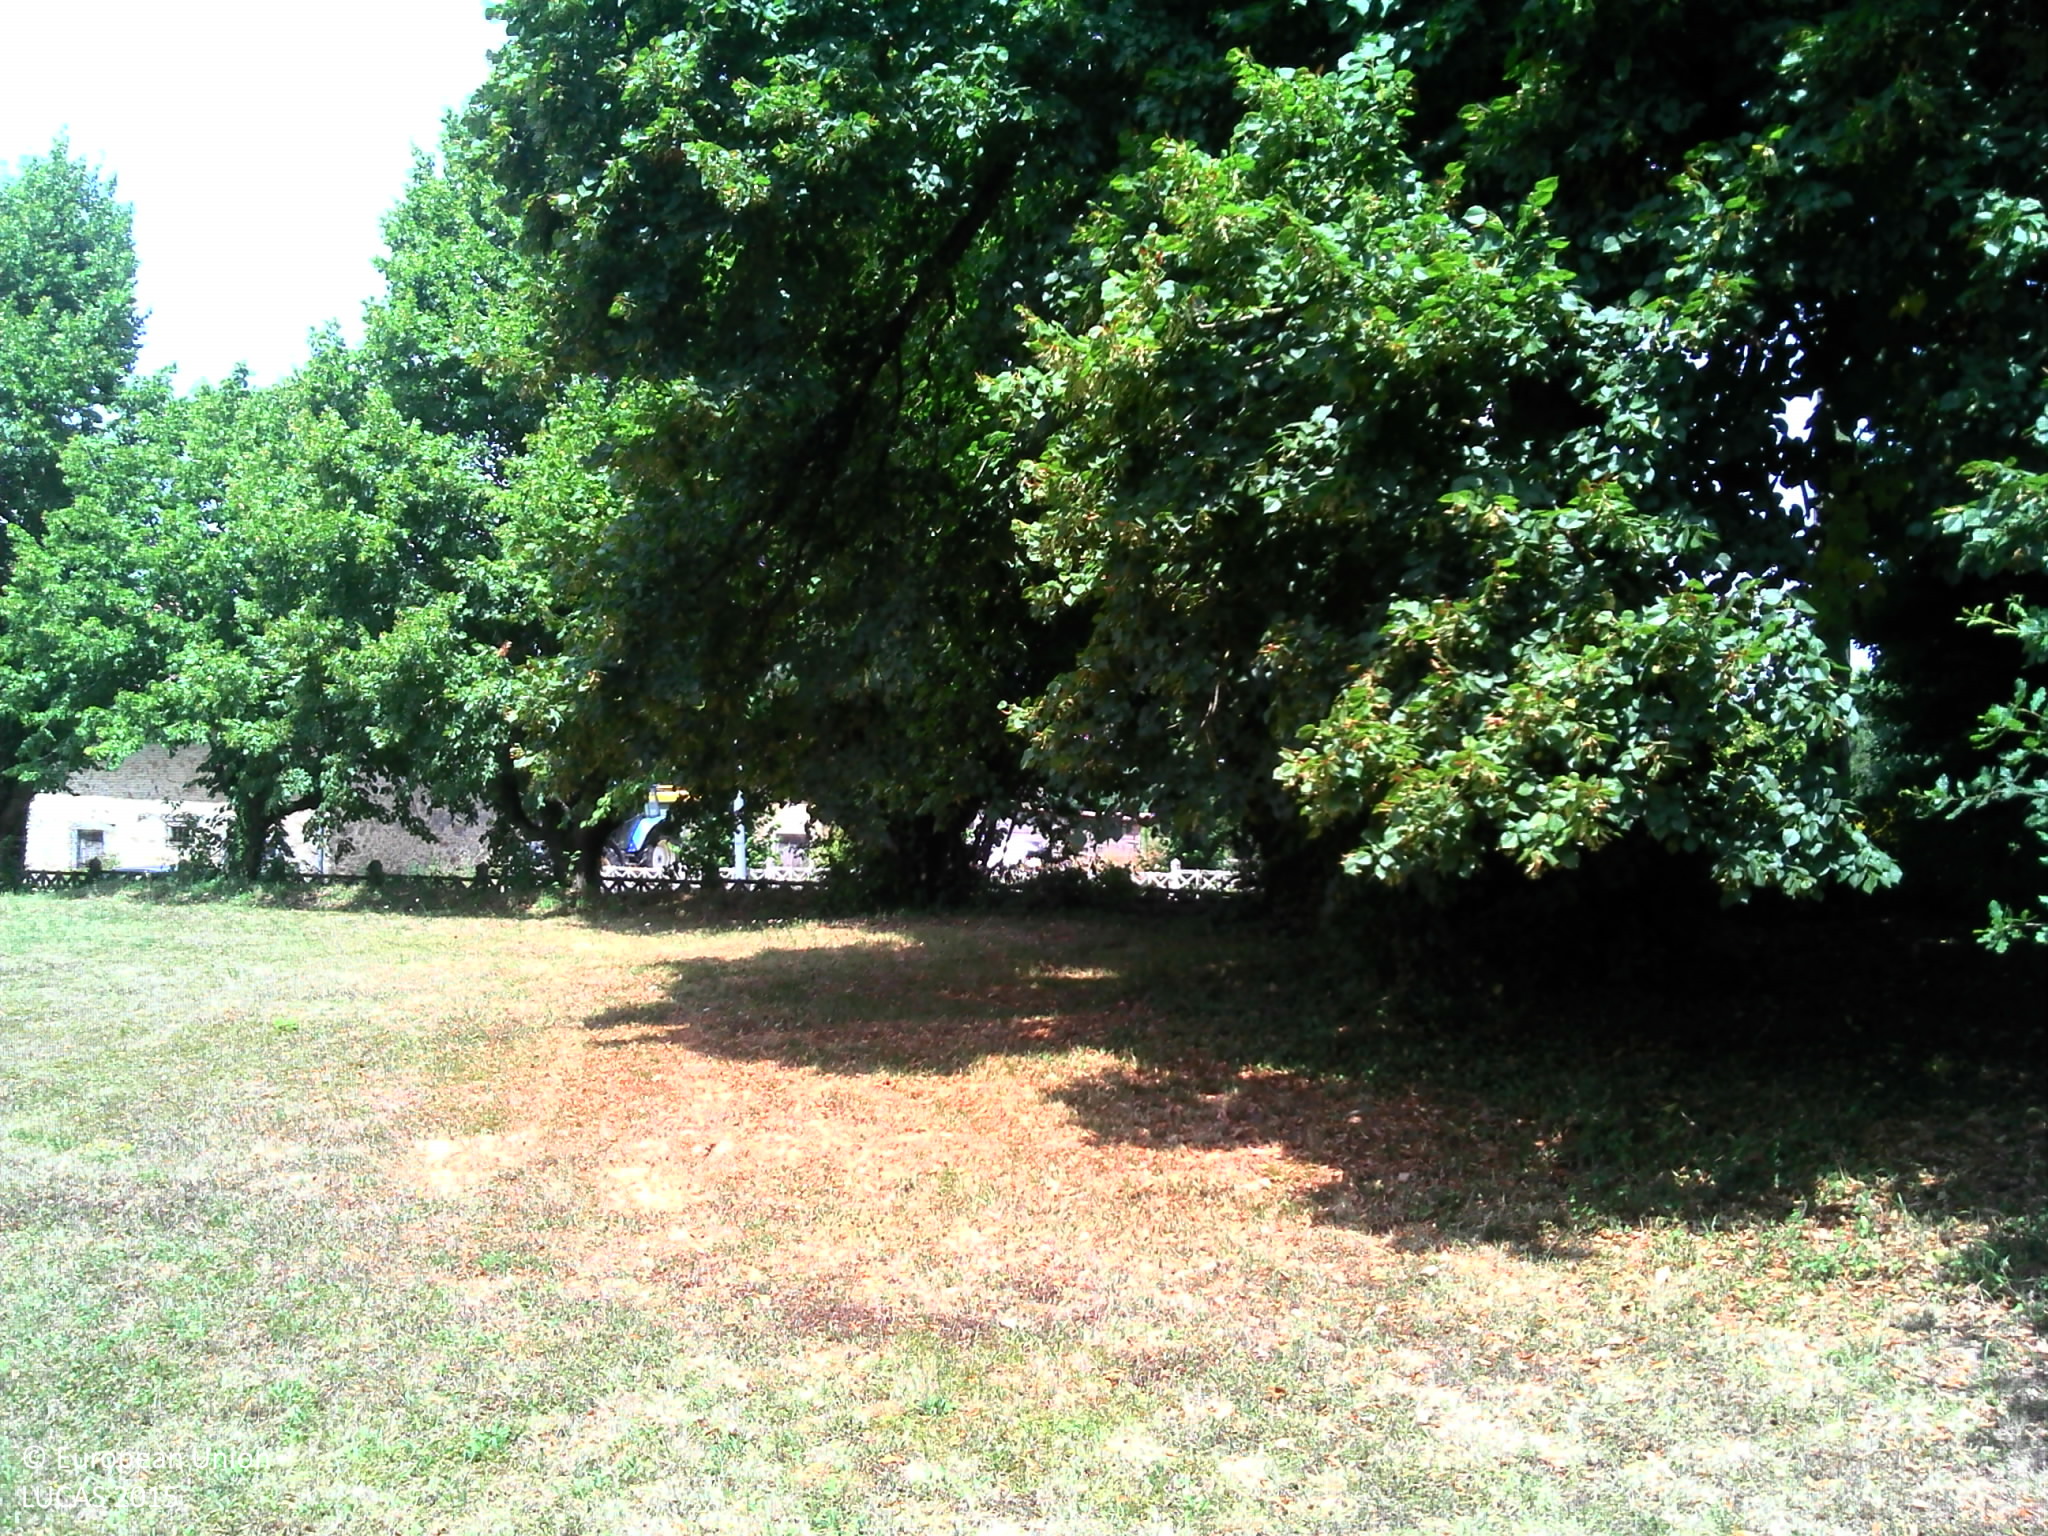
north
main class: Grassland
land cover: Grassland without tree/shrub cover
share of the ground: > 75 %
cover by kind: herbaceous plants 95 %
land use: Residential
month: July
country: FR
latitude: 45.7004
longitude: 1.0123
